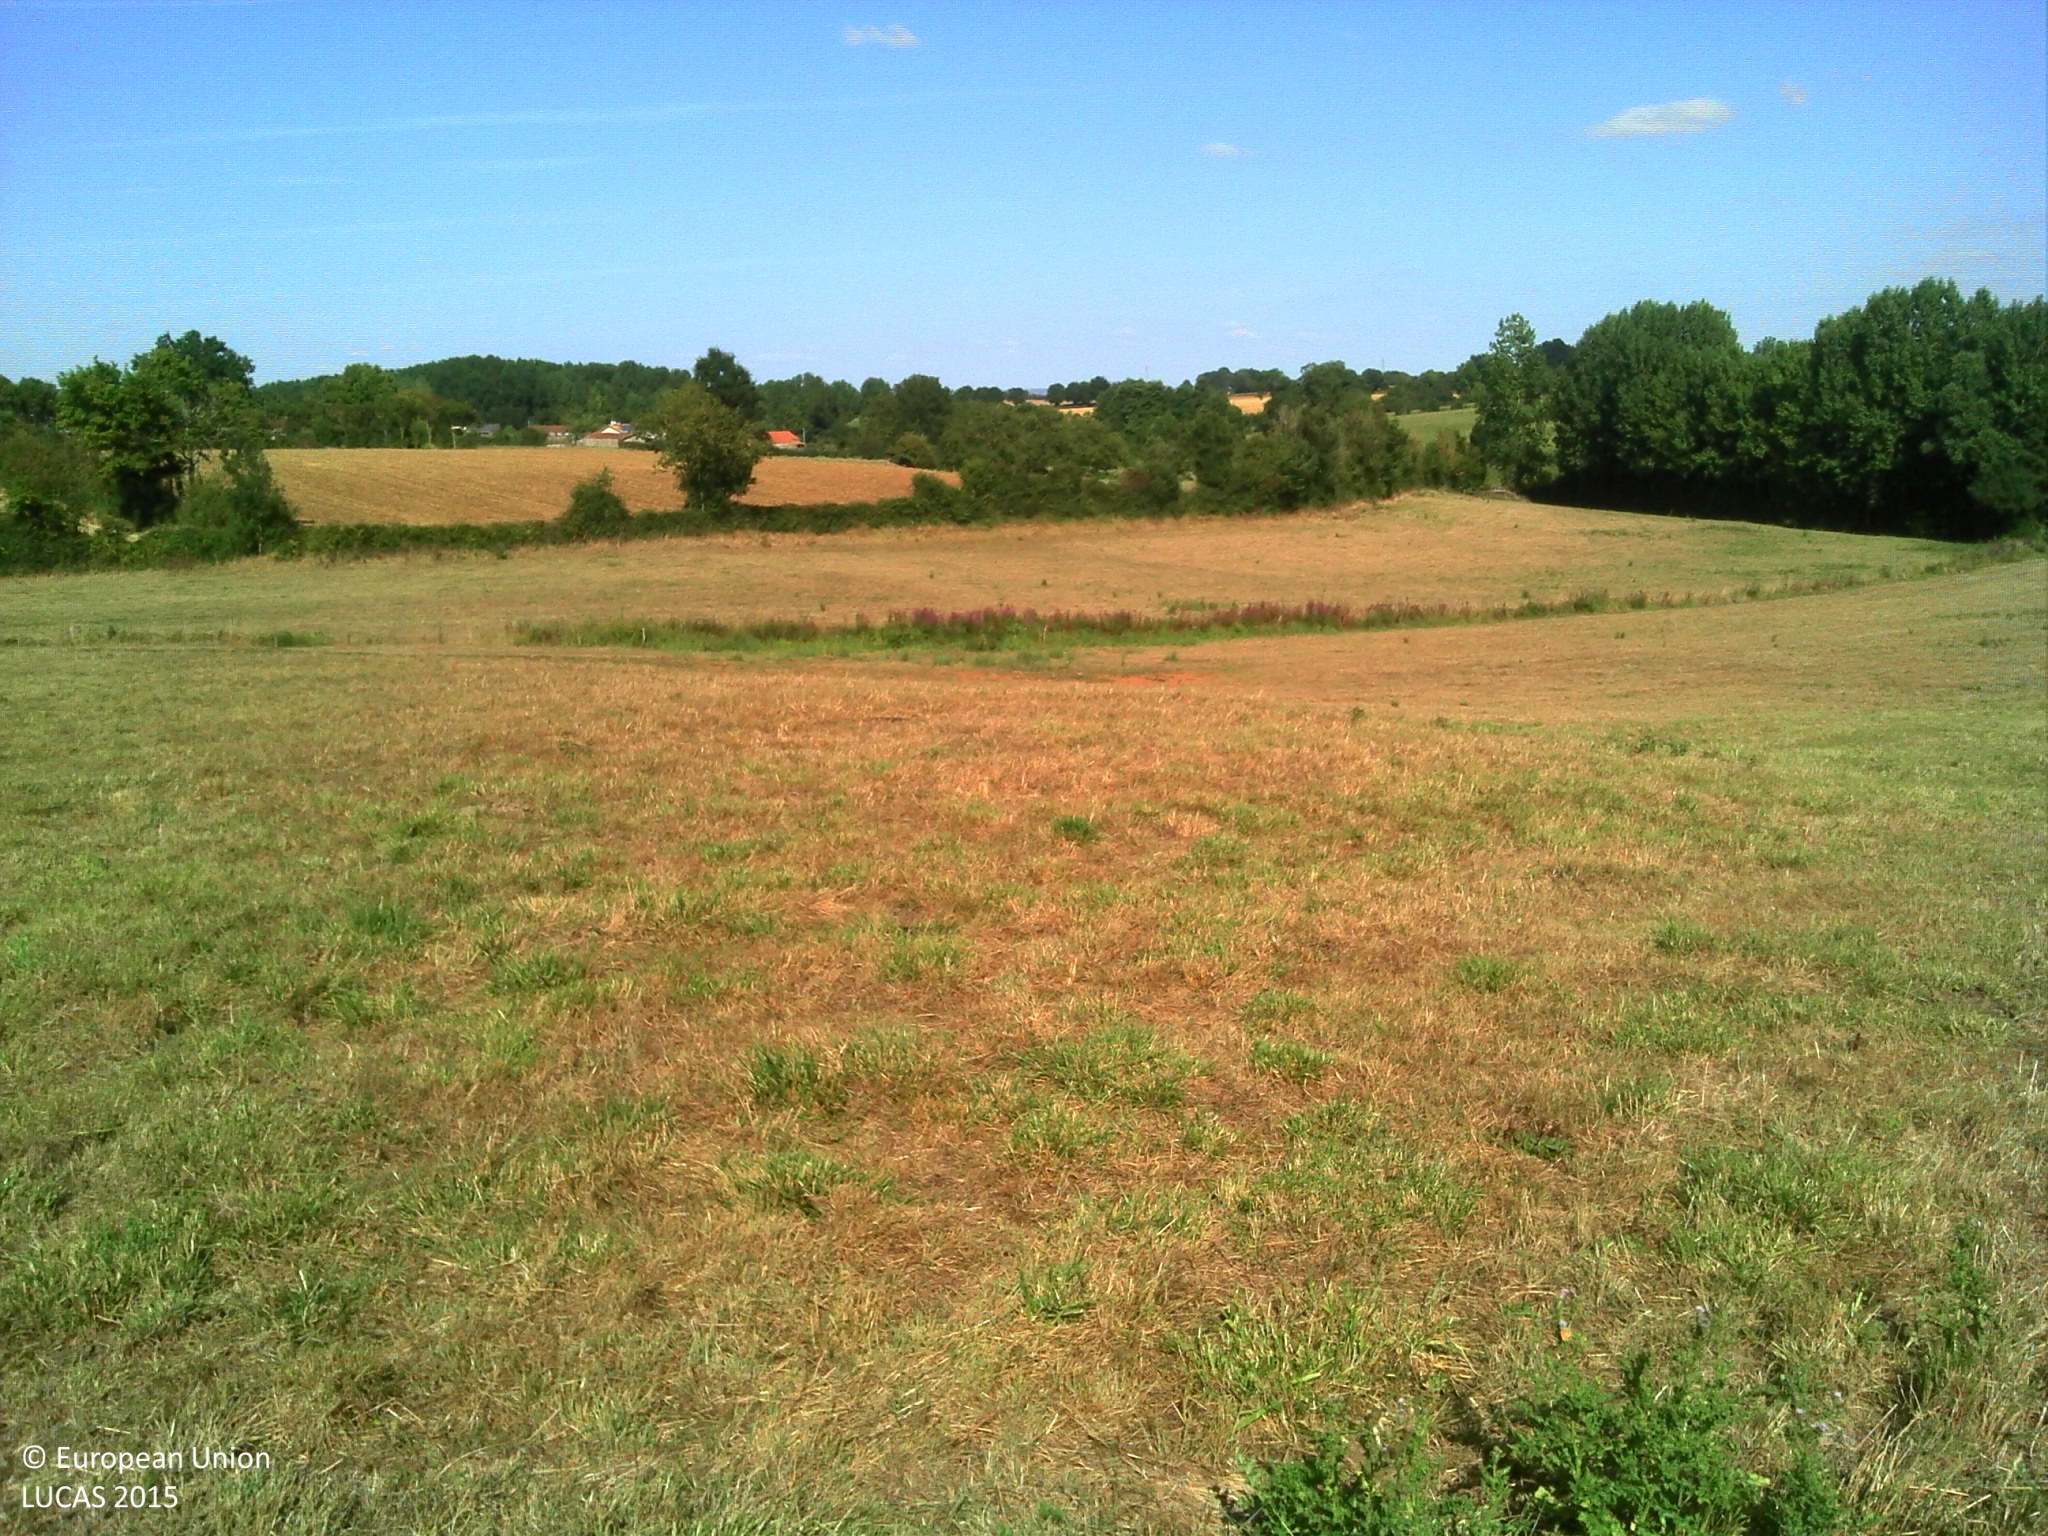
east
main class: Grassland
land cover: Grassland without tree/shrub cover
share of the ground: > 75 %
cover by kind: herbaceous plants 100 %
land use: Agriculture (excluding fallow land and kitchen gardens)
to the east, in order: Grassland without tree/shrub cover; Fences; Ditches and canals; Fences; Grassland without tree/shrub cover
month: August
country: FR
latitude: 46.7150
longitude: -1.1146
